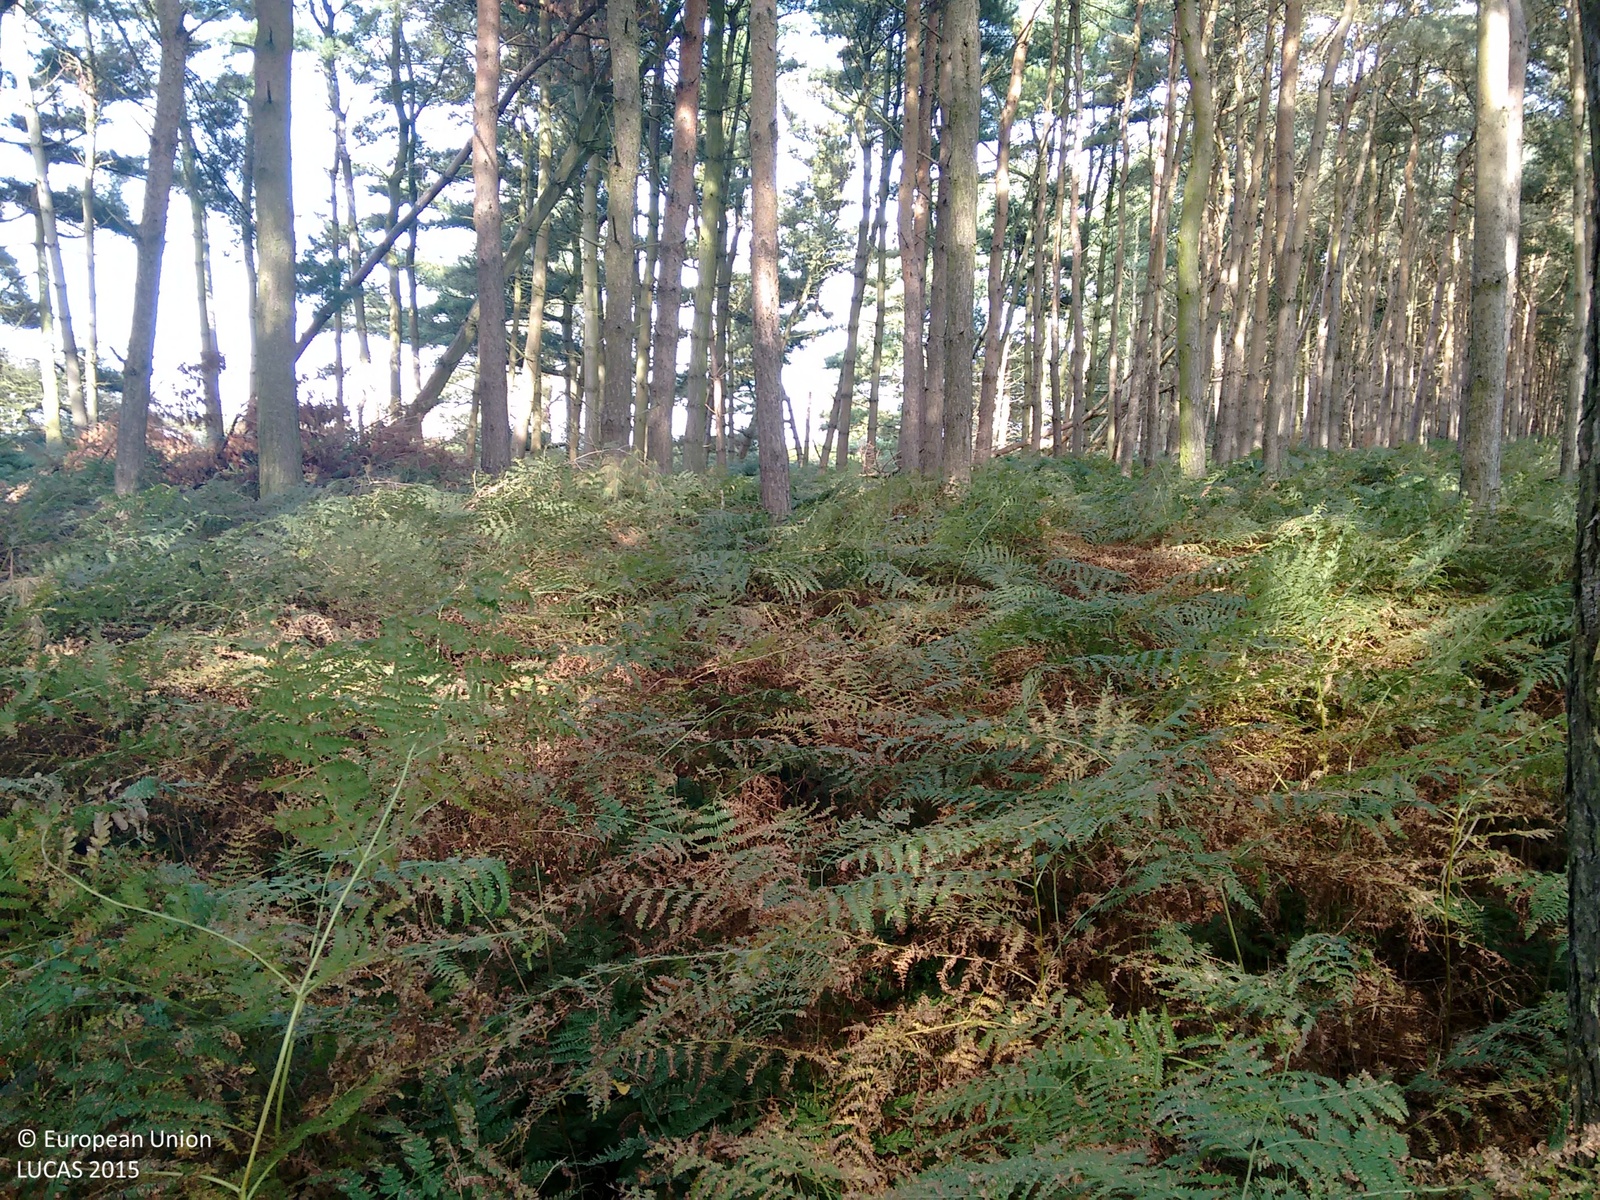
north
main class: Woodland
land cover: Pine dominated mixed woodland
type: exotic forest
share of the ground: > 75 %
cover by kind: coniferous forest trees 75 %, broadleaved forest trees 25 %
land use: Forestry
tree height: > 5 m
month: September
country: GB
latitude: 52.4568
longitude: 0.8367
